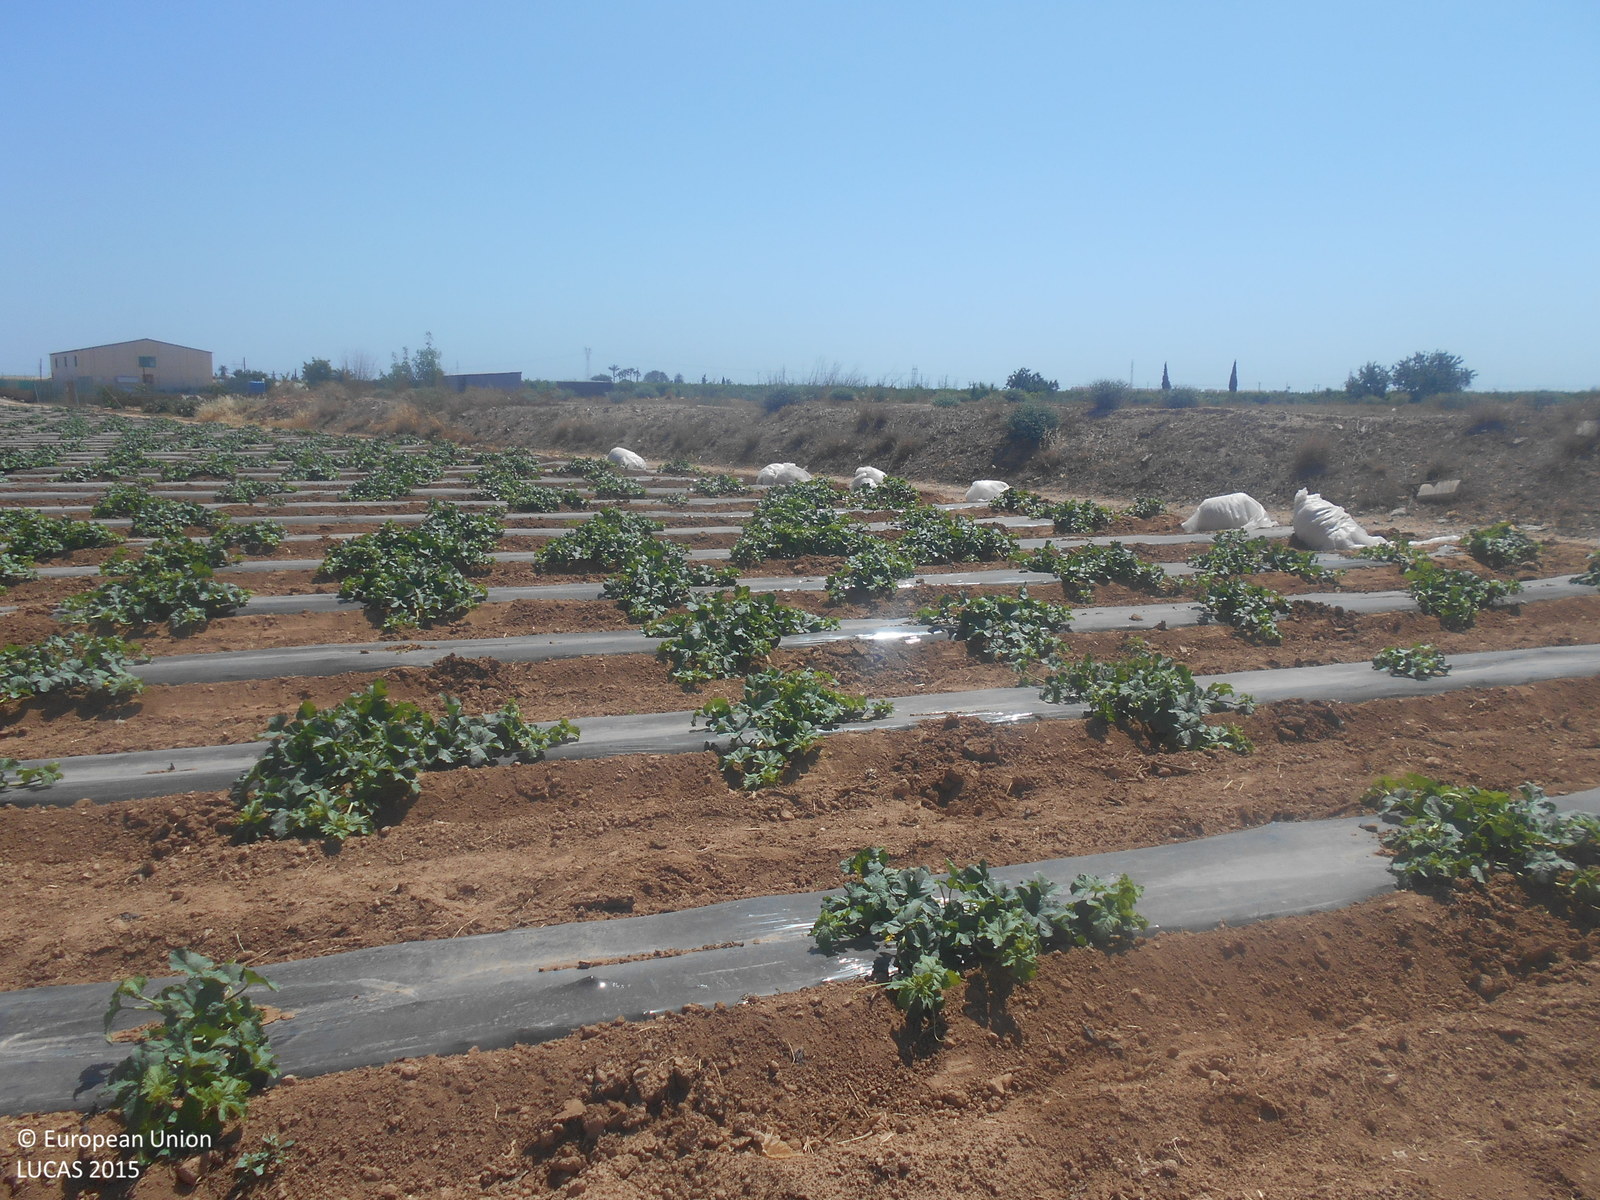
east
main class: Cropland
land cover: Other fresh vegetables
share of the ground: 10 - 25 %
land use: Agriculture (excluding fallow land and kitchen gardens)
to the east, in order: Other fresh vegetables; Tracks; Grassland without tree/shrub cover; Tracks; Other fresh vegetables; Fences; Olive groves; Fences; Oranges; Tracks; Oranges; Tracks; Oranges
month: May
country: ES
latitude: 37.7808
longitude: -0.8689
